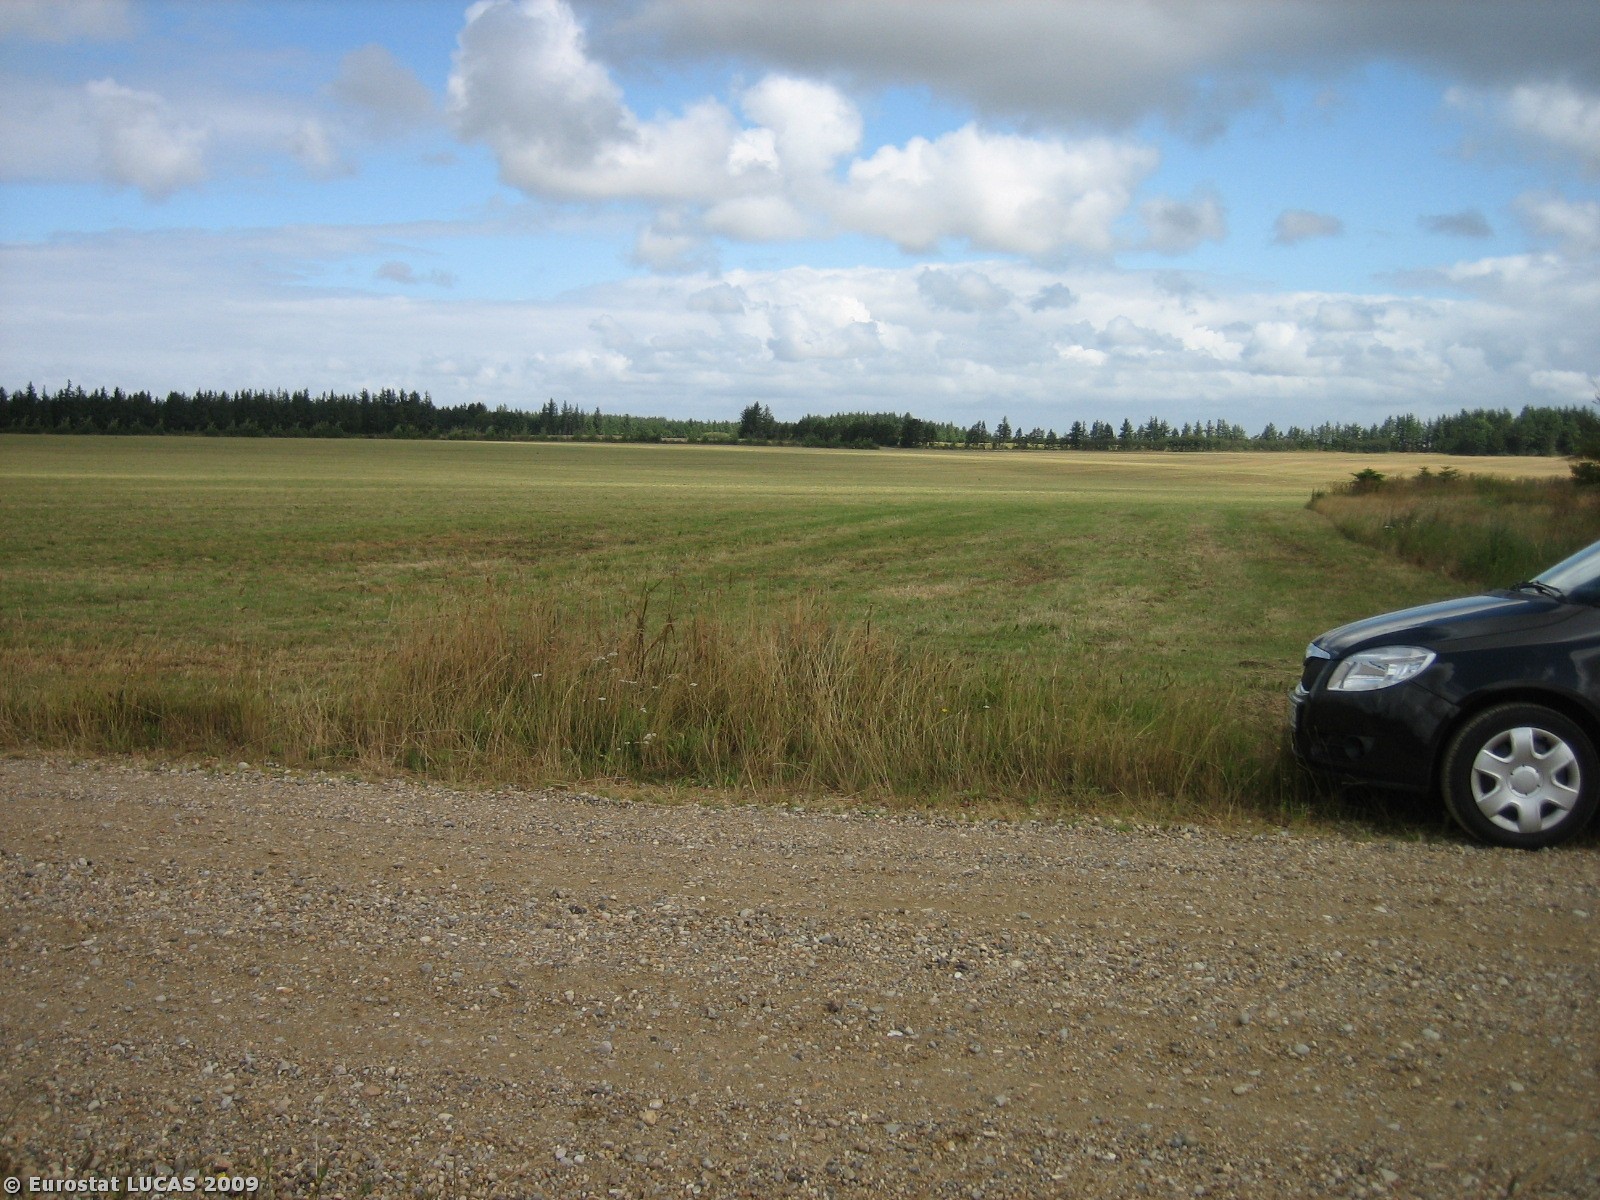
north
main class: Cropland
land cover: Clovers
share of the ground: > 75 %
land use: Agriculture (excluding fallow land and kitchen gardens)
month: July
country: DK
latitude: 55.8372
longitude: 8.4846
